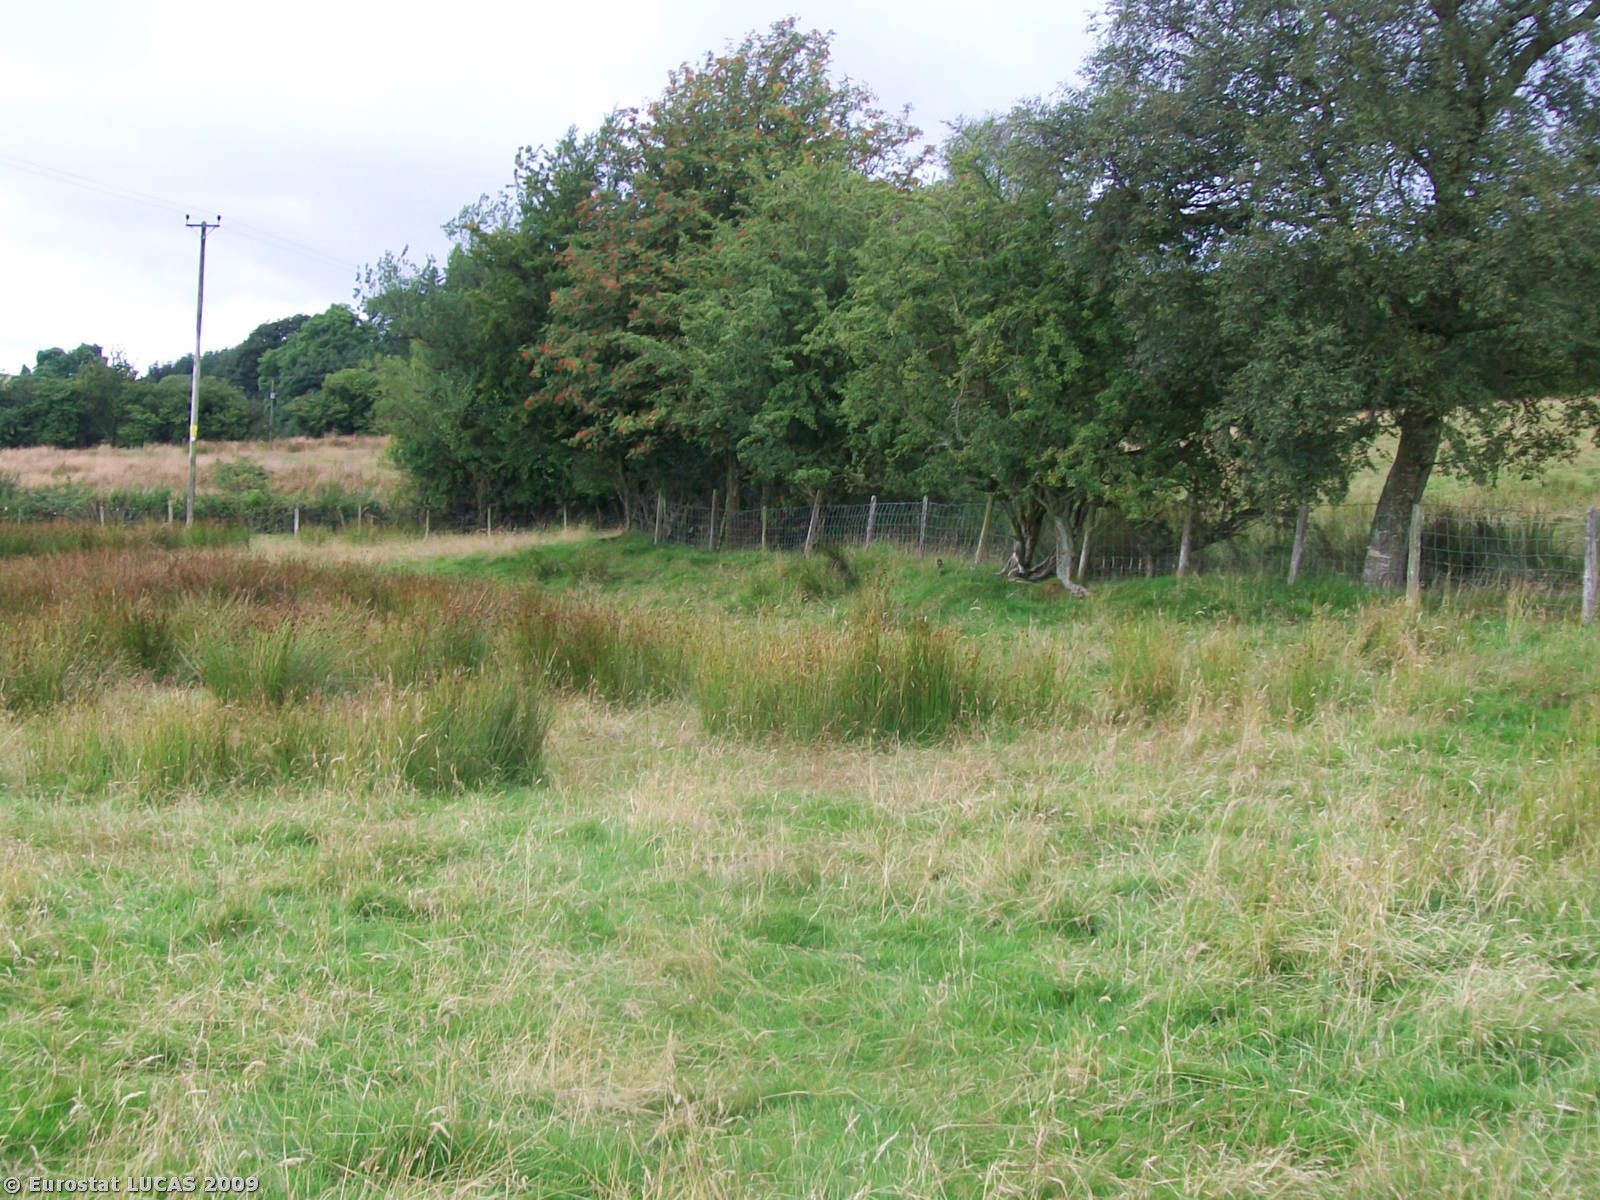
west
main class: Grassland
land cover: Grassland without tree/shrub cover
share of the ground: > 75 %
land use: Agriculture (excluding fallow land and kitchen gardens)
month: August
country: GB
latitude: 52.7616
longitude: -3.4047
